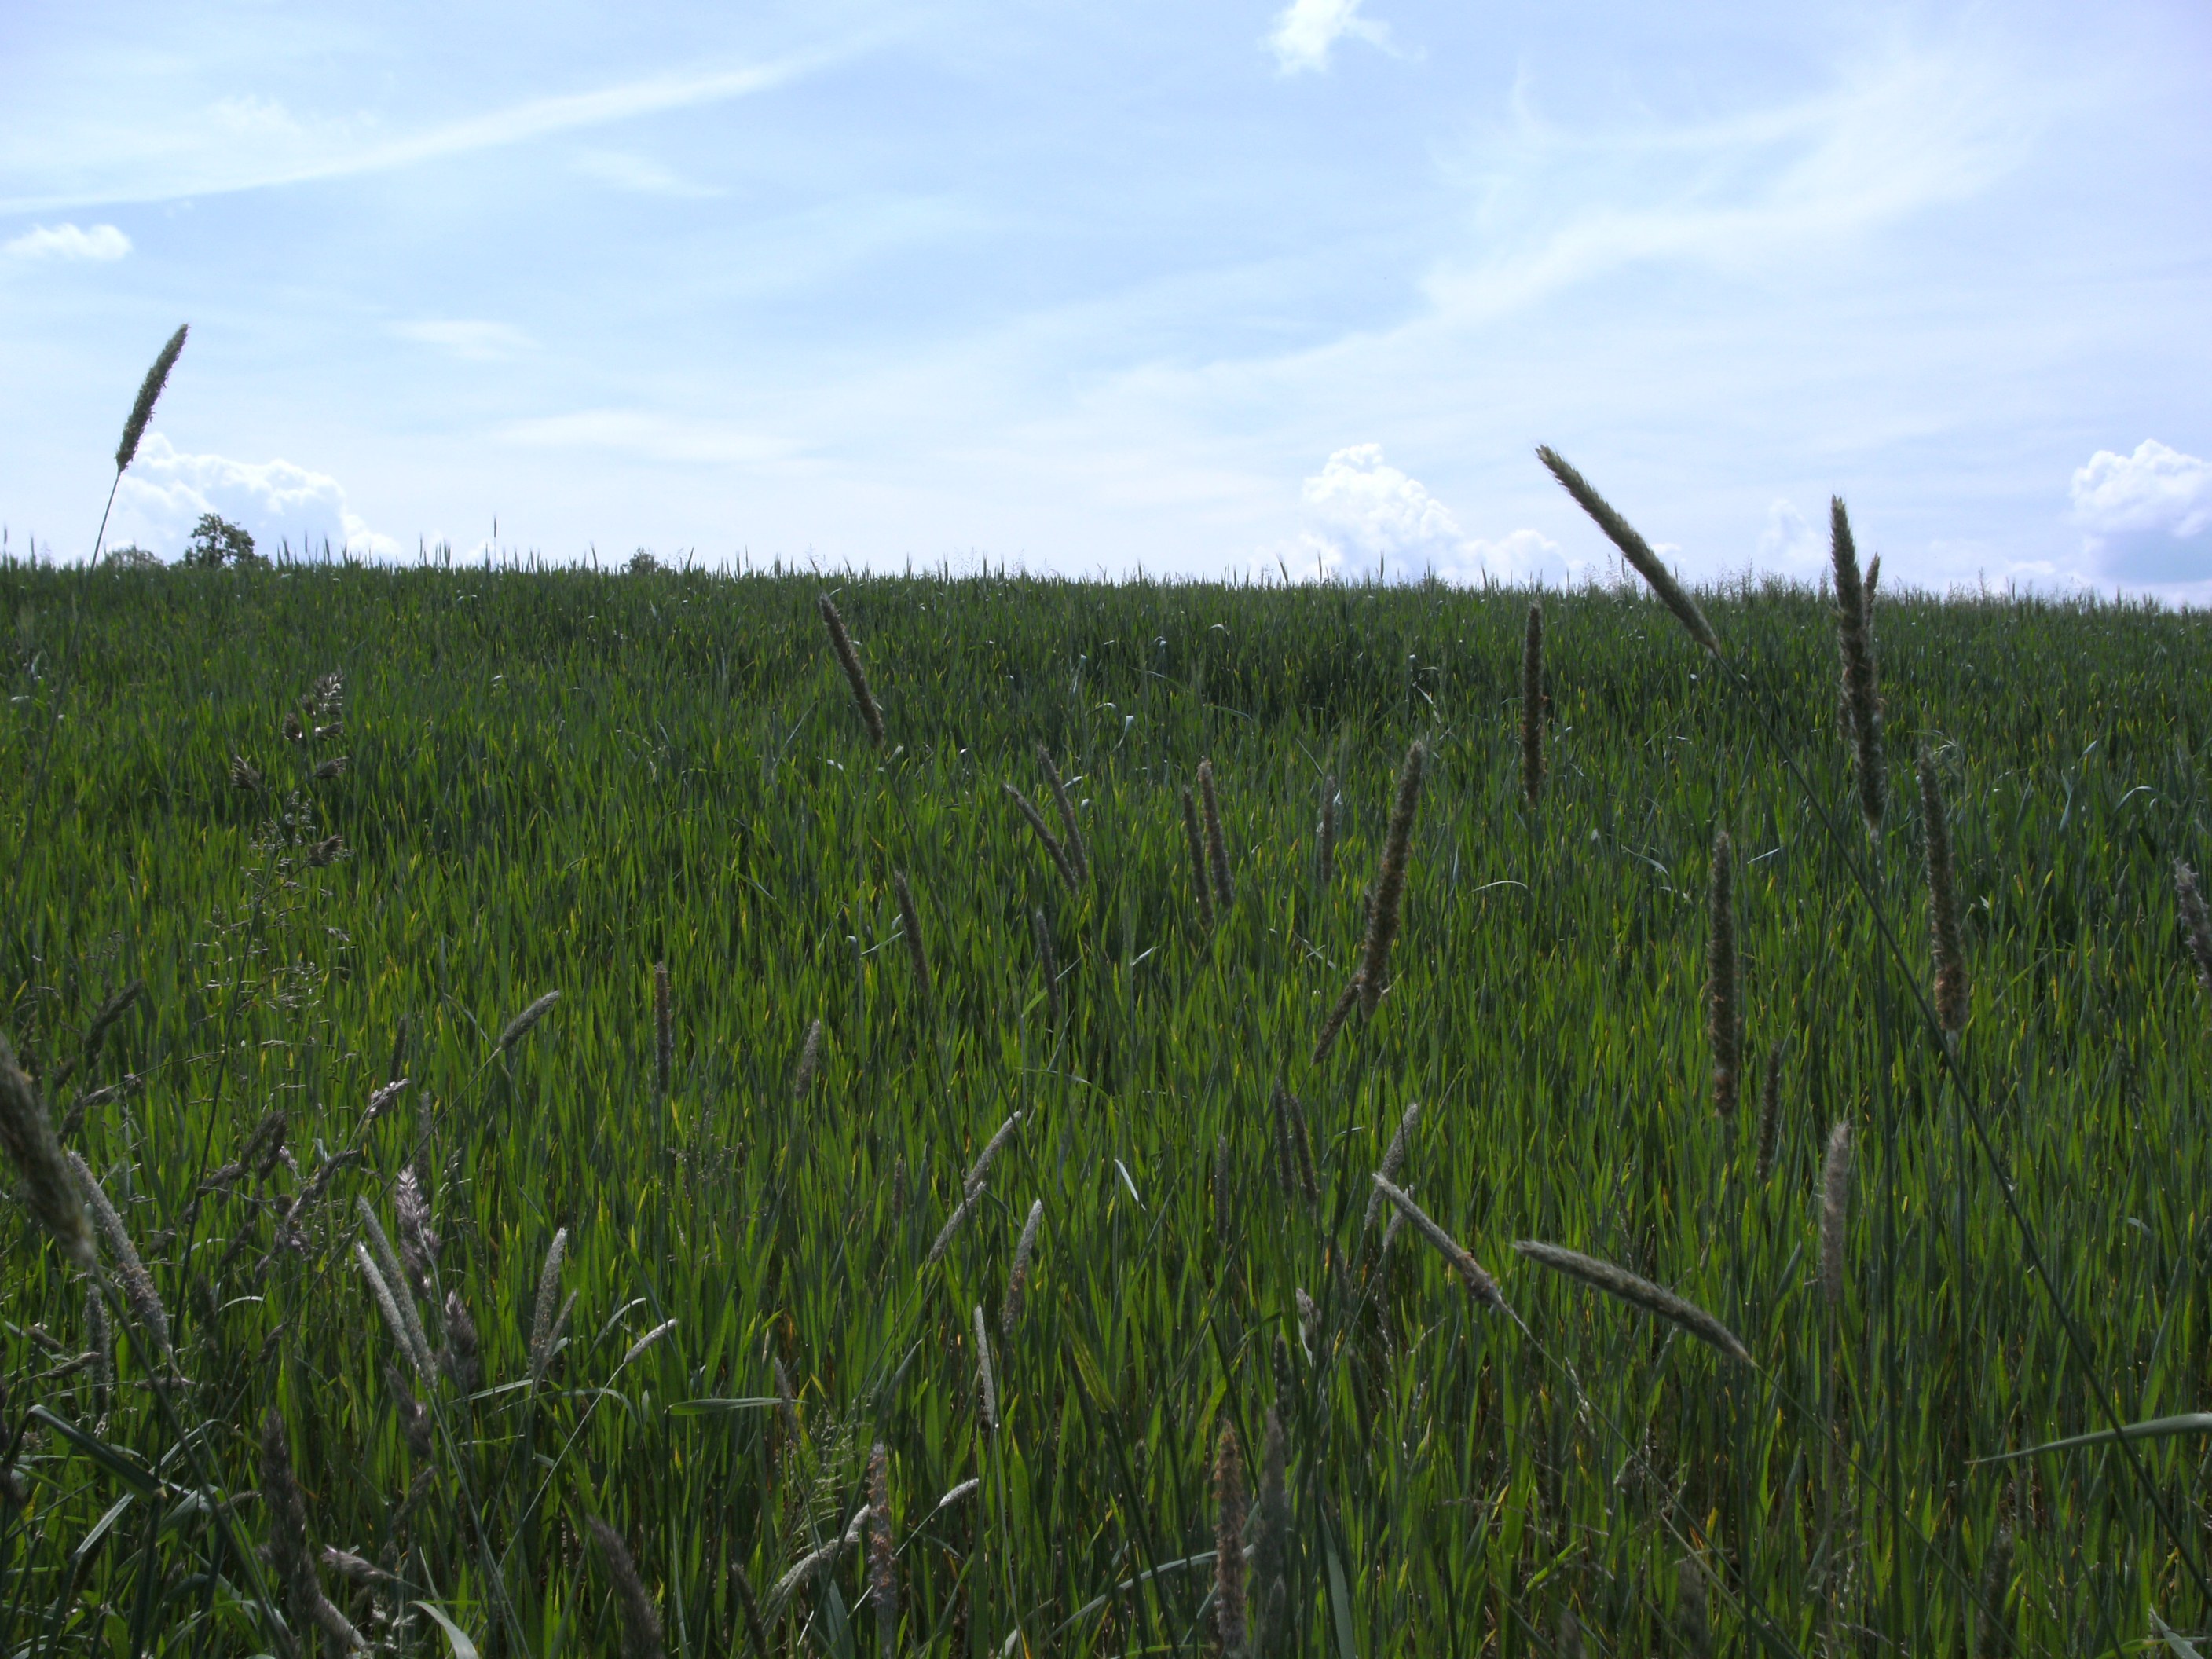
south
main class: Cropland
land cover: Triticale
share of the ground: > 75 %
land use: Agriculture (excluding fallow land and kitchen gardens)
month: June
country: AT
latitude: 48.0599
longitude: 13.5012
